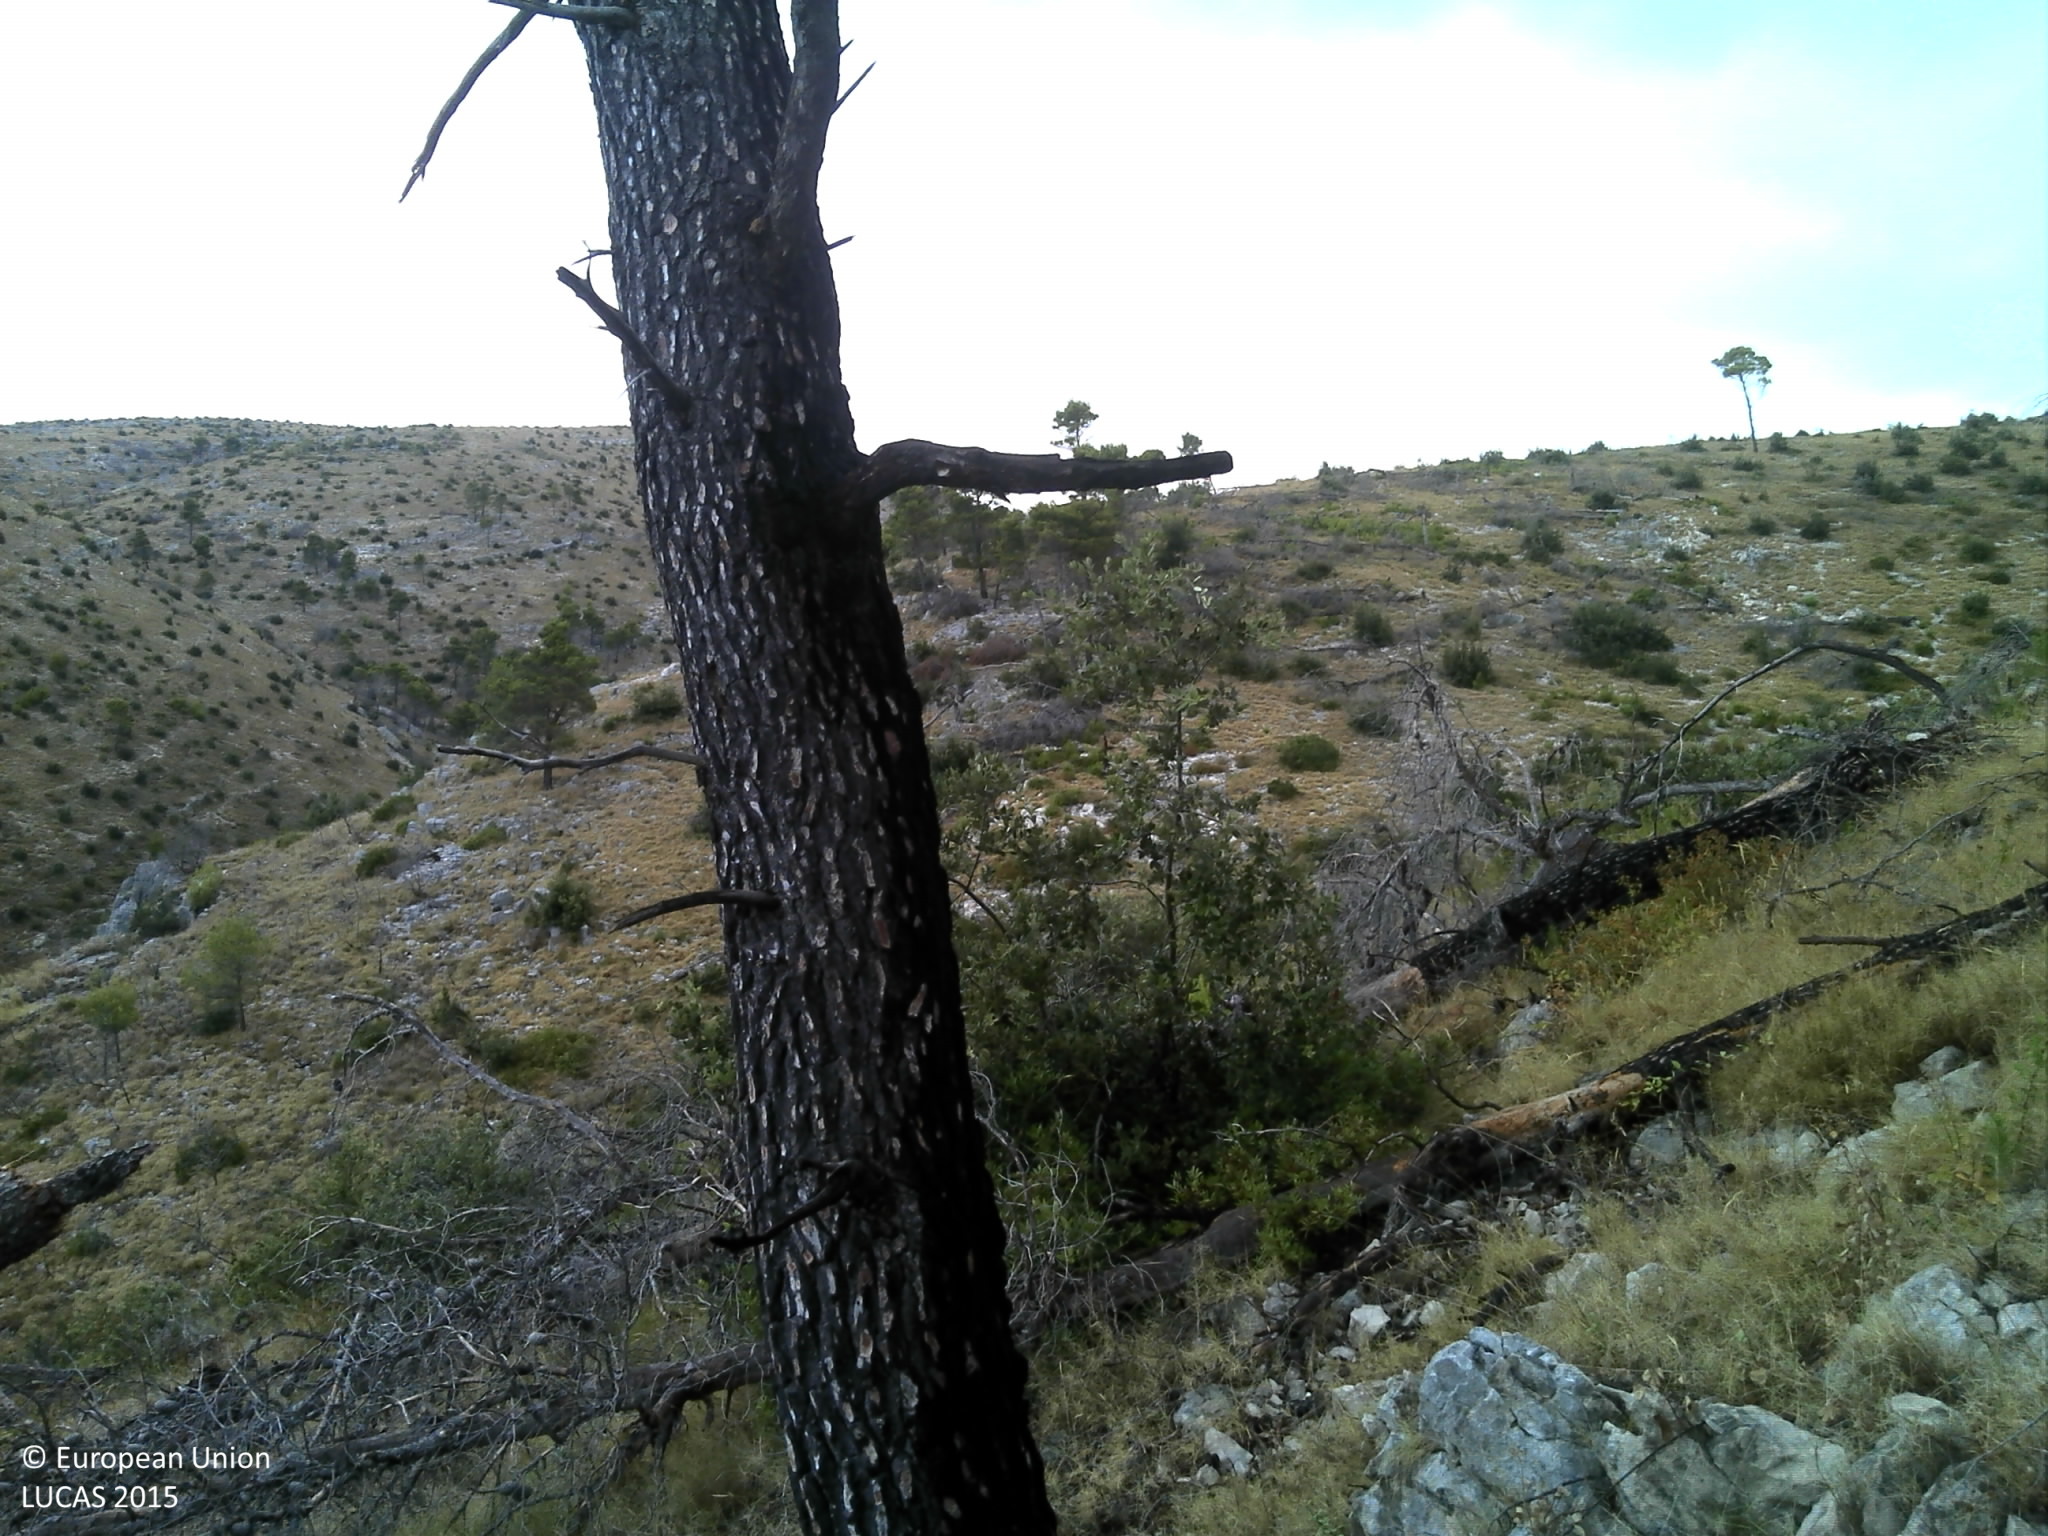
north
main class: Woodland
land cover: Pine dominated coniferous woodland
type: coniferous forest of the mediterranean region
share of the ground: 50 - 75 %
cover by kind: coniferous forest trees 50 %, shrubs 20 %, unconsolidated bare surface 15 %, herbaceous plants 10 %, consolidated bare surface 5 %
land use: Semi-natural and natural areas not in use
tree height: > 5 m
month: July
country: HR
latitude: 43.2971
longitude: 16.4859
